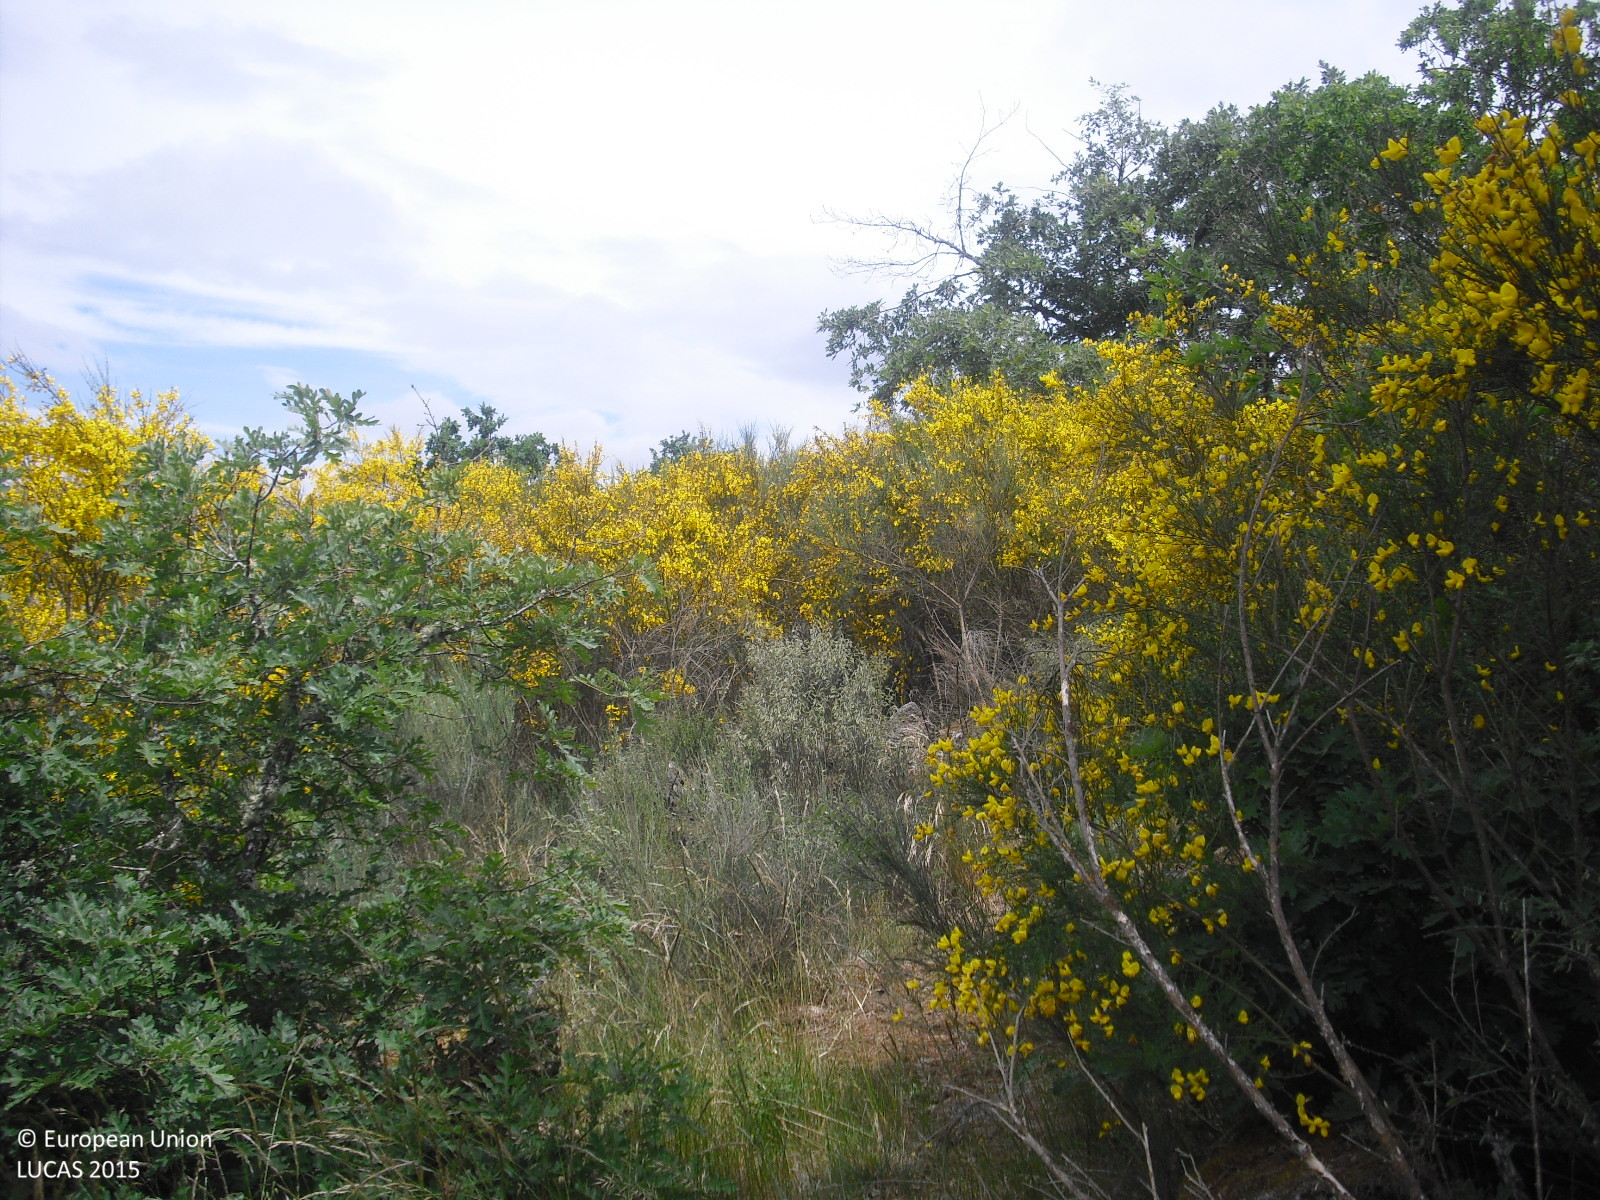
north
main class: Woodland
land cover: Pine dominated mixed woodland
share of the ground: 50 - 75 %
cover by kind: coniferous forest trees 50 %, shrubs 30 %, broadleaved forest trees 20 %
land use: Forestry
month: May
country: ES
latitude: 42.1553
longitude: -7.8774
